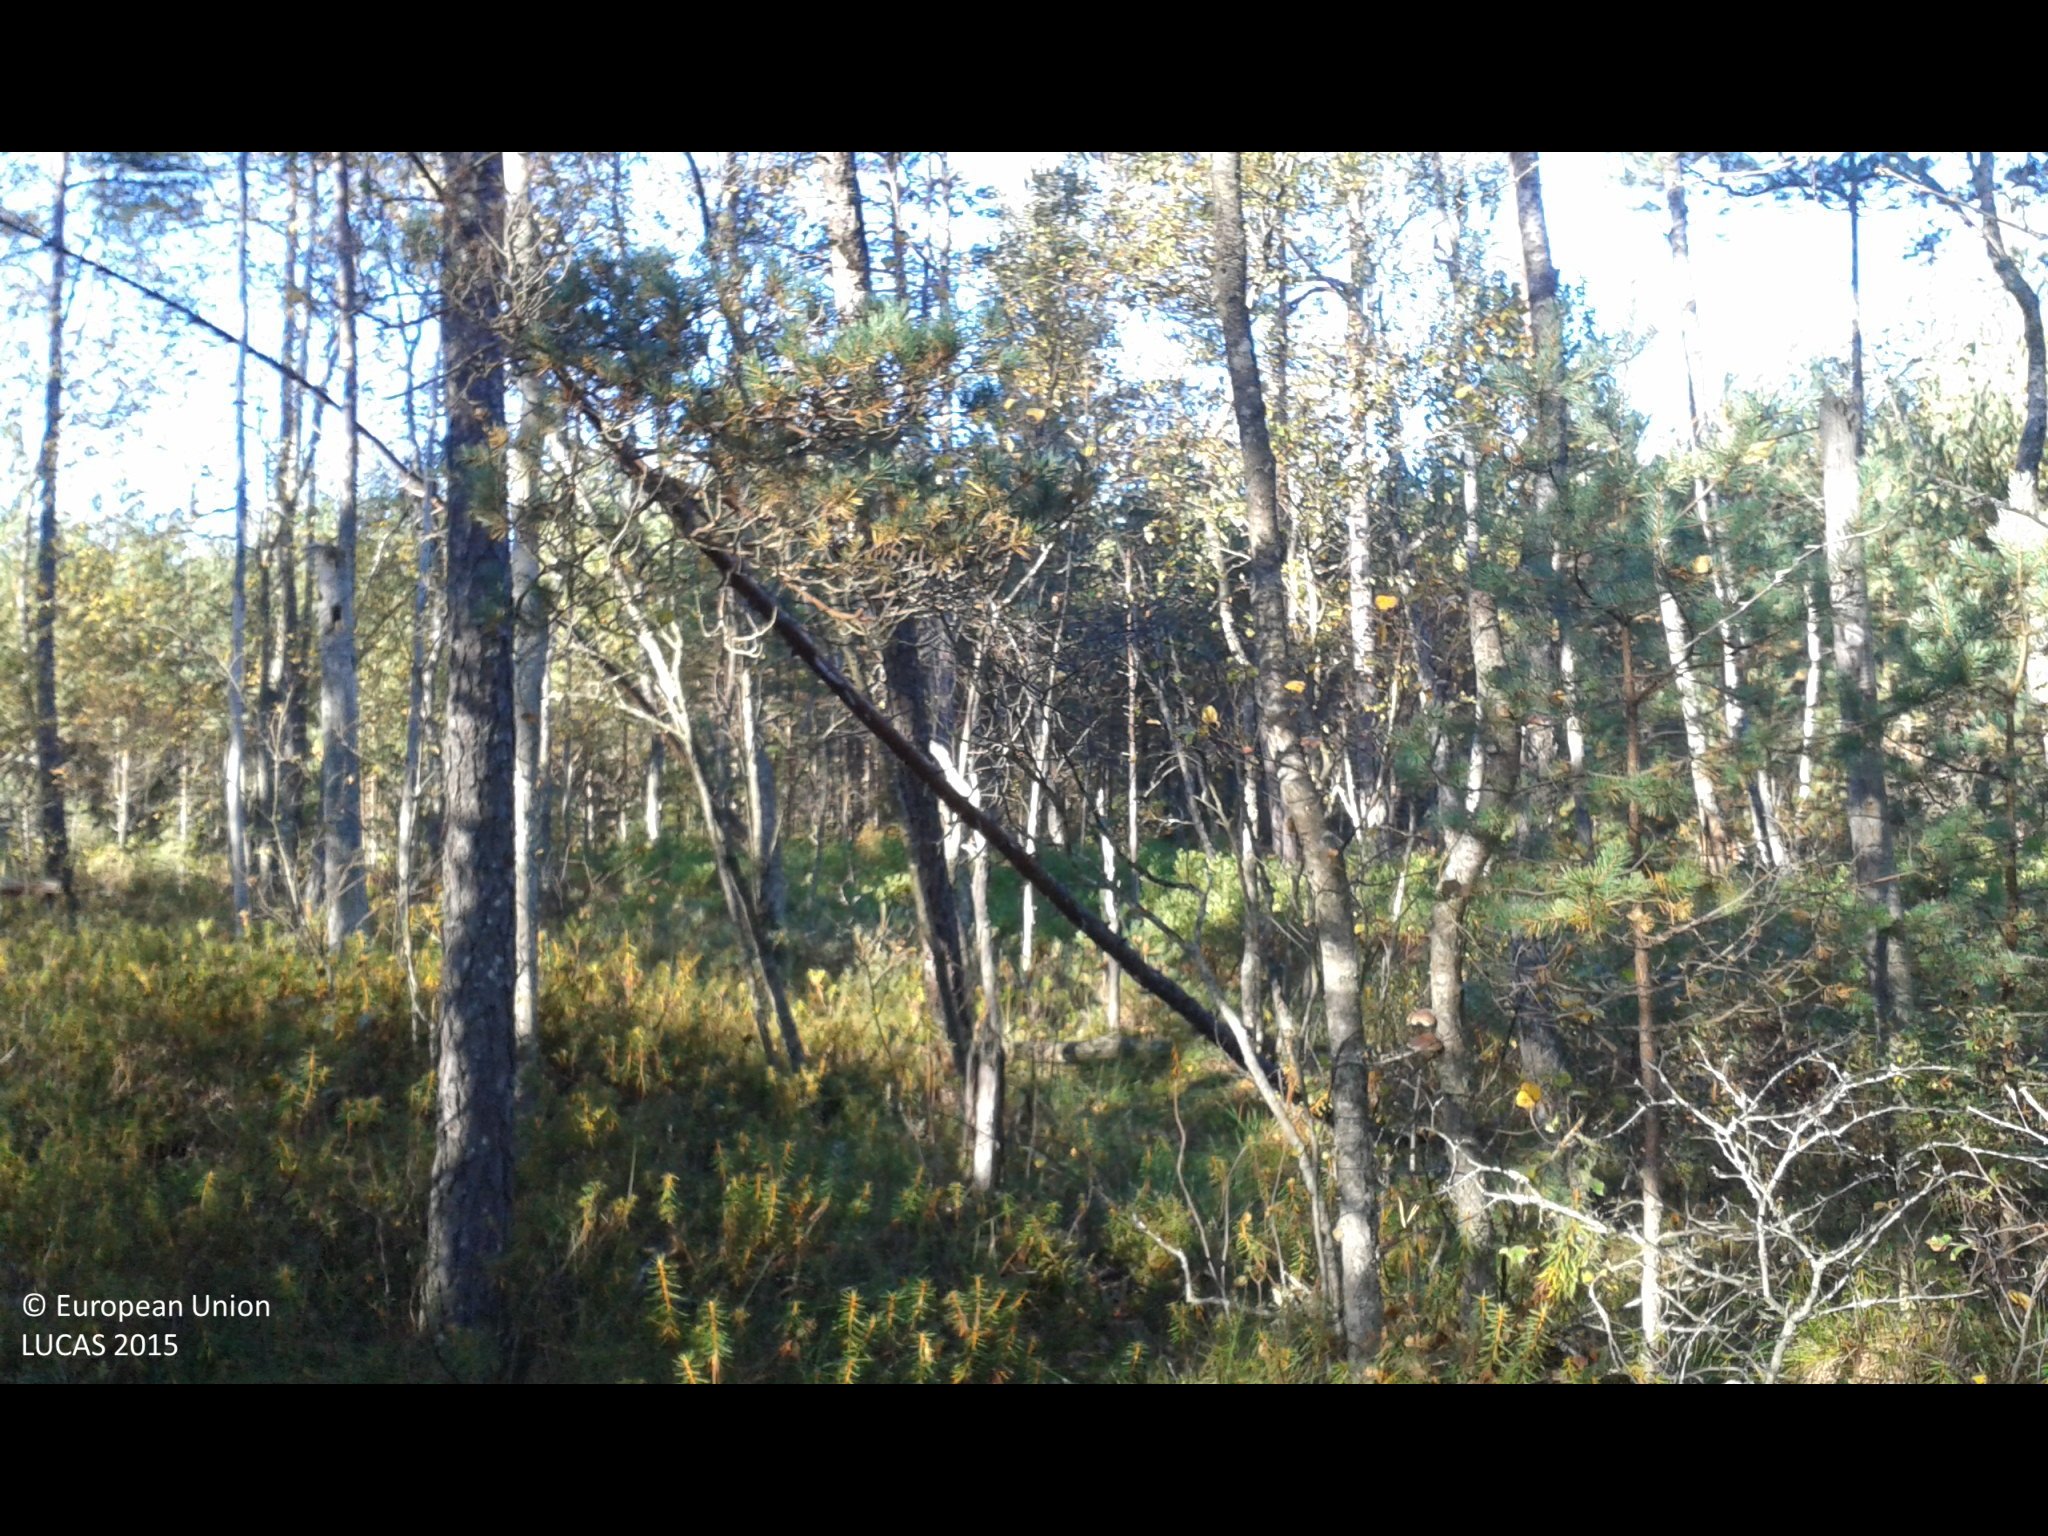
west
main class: Woodland
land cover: Pine dominated mixed woodland
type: hemiboreal forest and nemoral coniferous forest and mixed broadleaved-coniferous forest
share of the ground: 50 - 75 %
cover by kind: coniferous forest trees 35 %, broadleaved forest trees 35 %, herbaceous plants 30 %
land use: Forestry
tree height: > 5 m
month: September
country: SE
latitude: 59.0795
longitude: 17.4472
